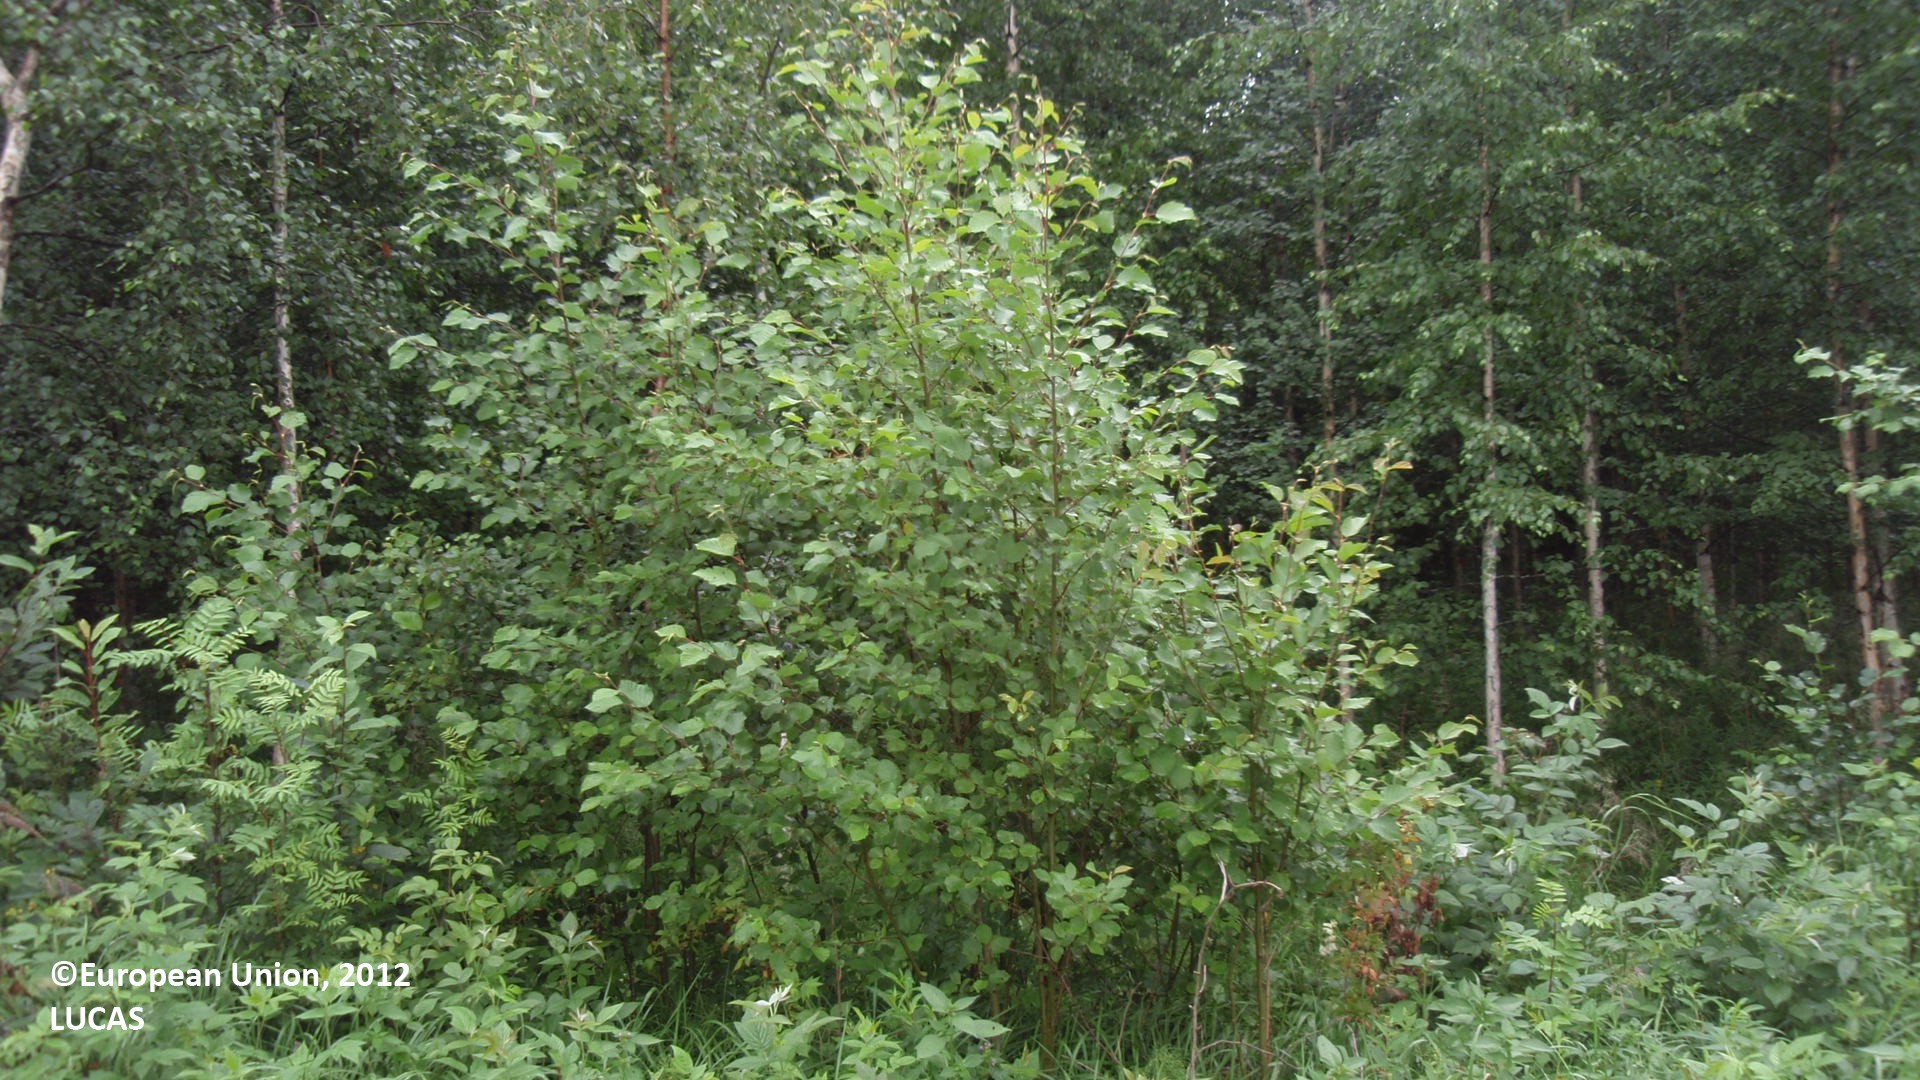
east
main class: Shrubland
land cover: Shrubland with sparse tree cover
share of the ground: > 75 %
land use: Fallow land
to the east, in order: Shrubland with sparse tree cover
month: July
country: FI
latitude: 61.1521
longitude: 28.6327
